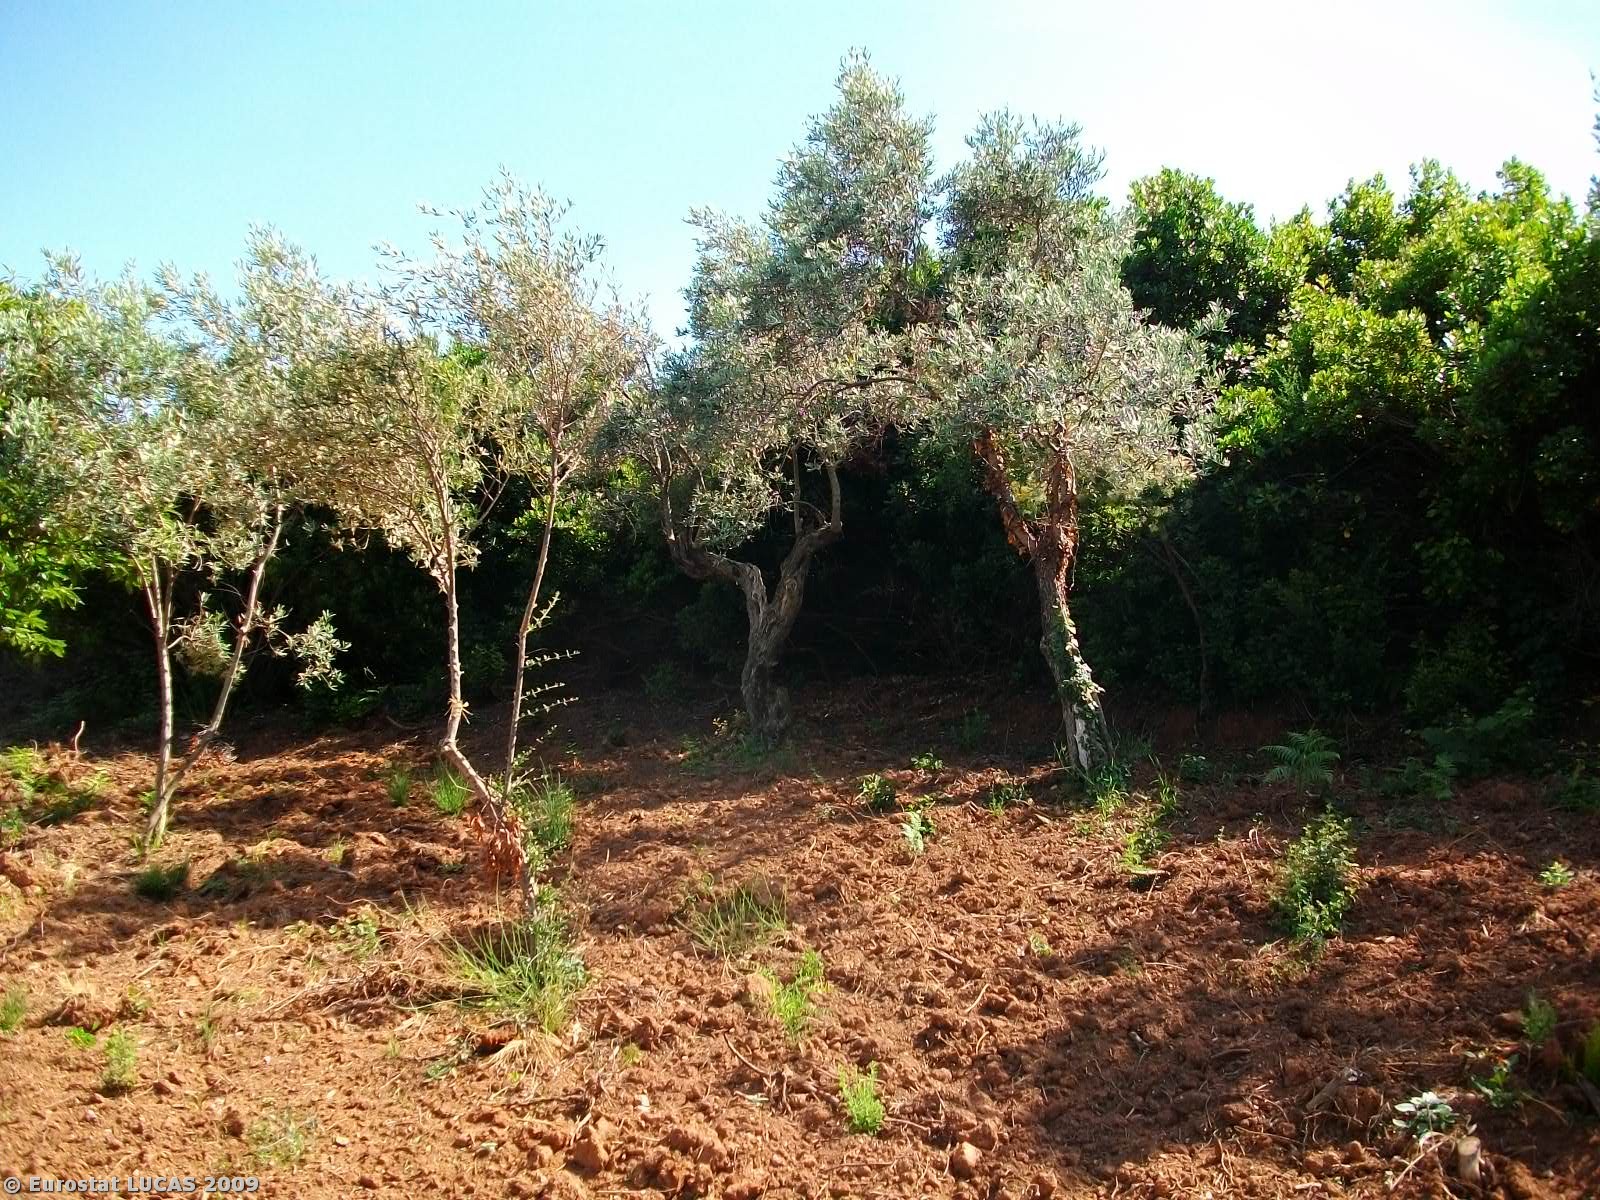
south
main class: Shrubland
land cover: Shrubland with sparse tree cover
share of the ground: > 75 %
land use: Nature reserves
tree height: < 5 m
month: June
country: GR
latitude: 39.3513
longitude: 23.2114
